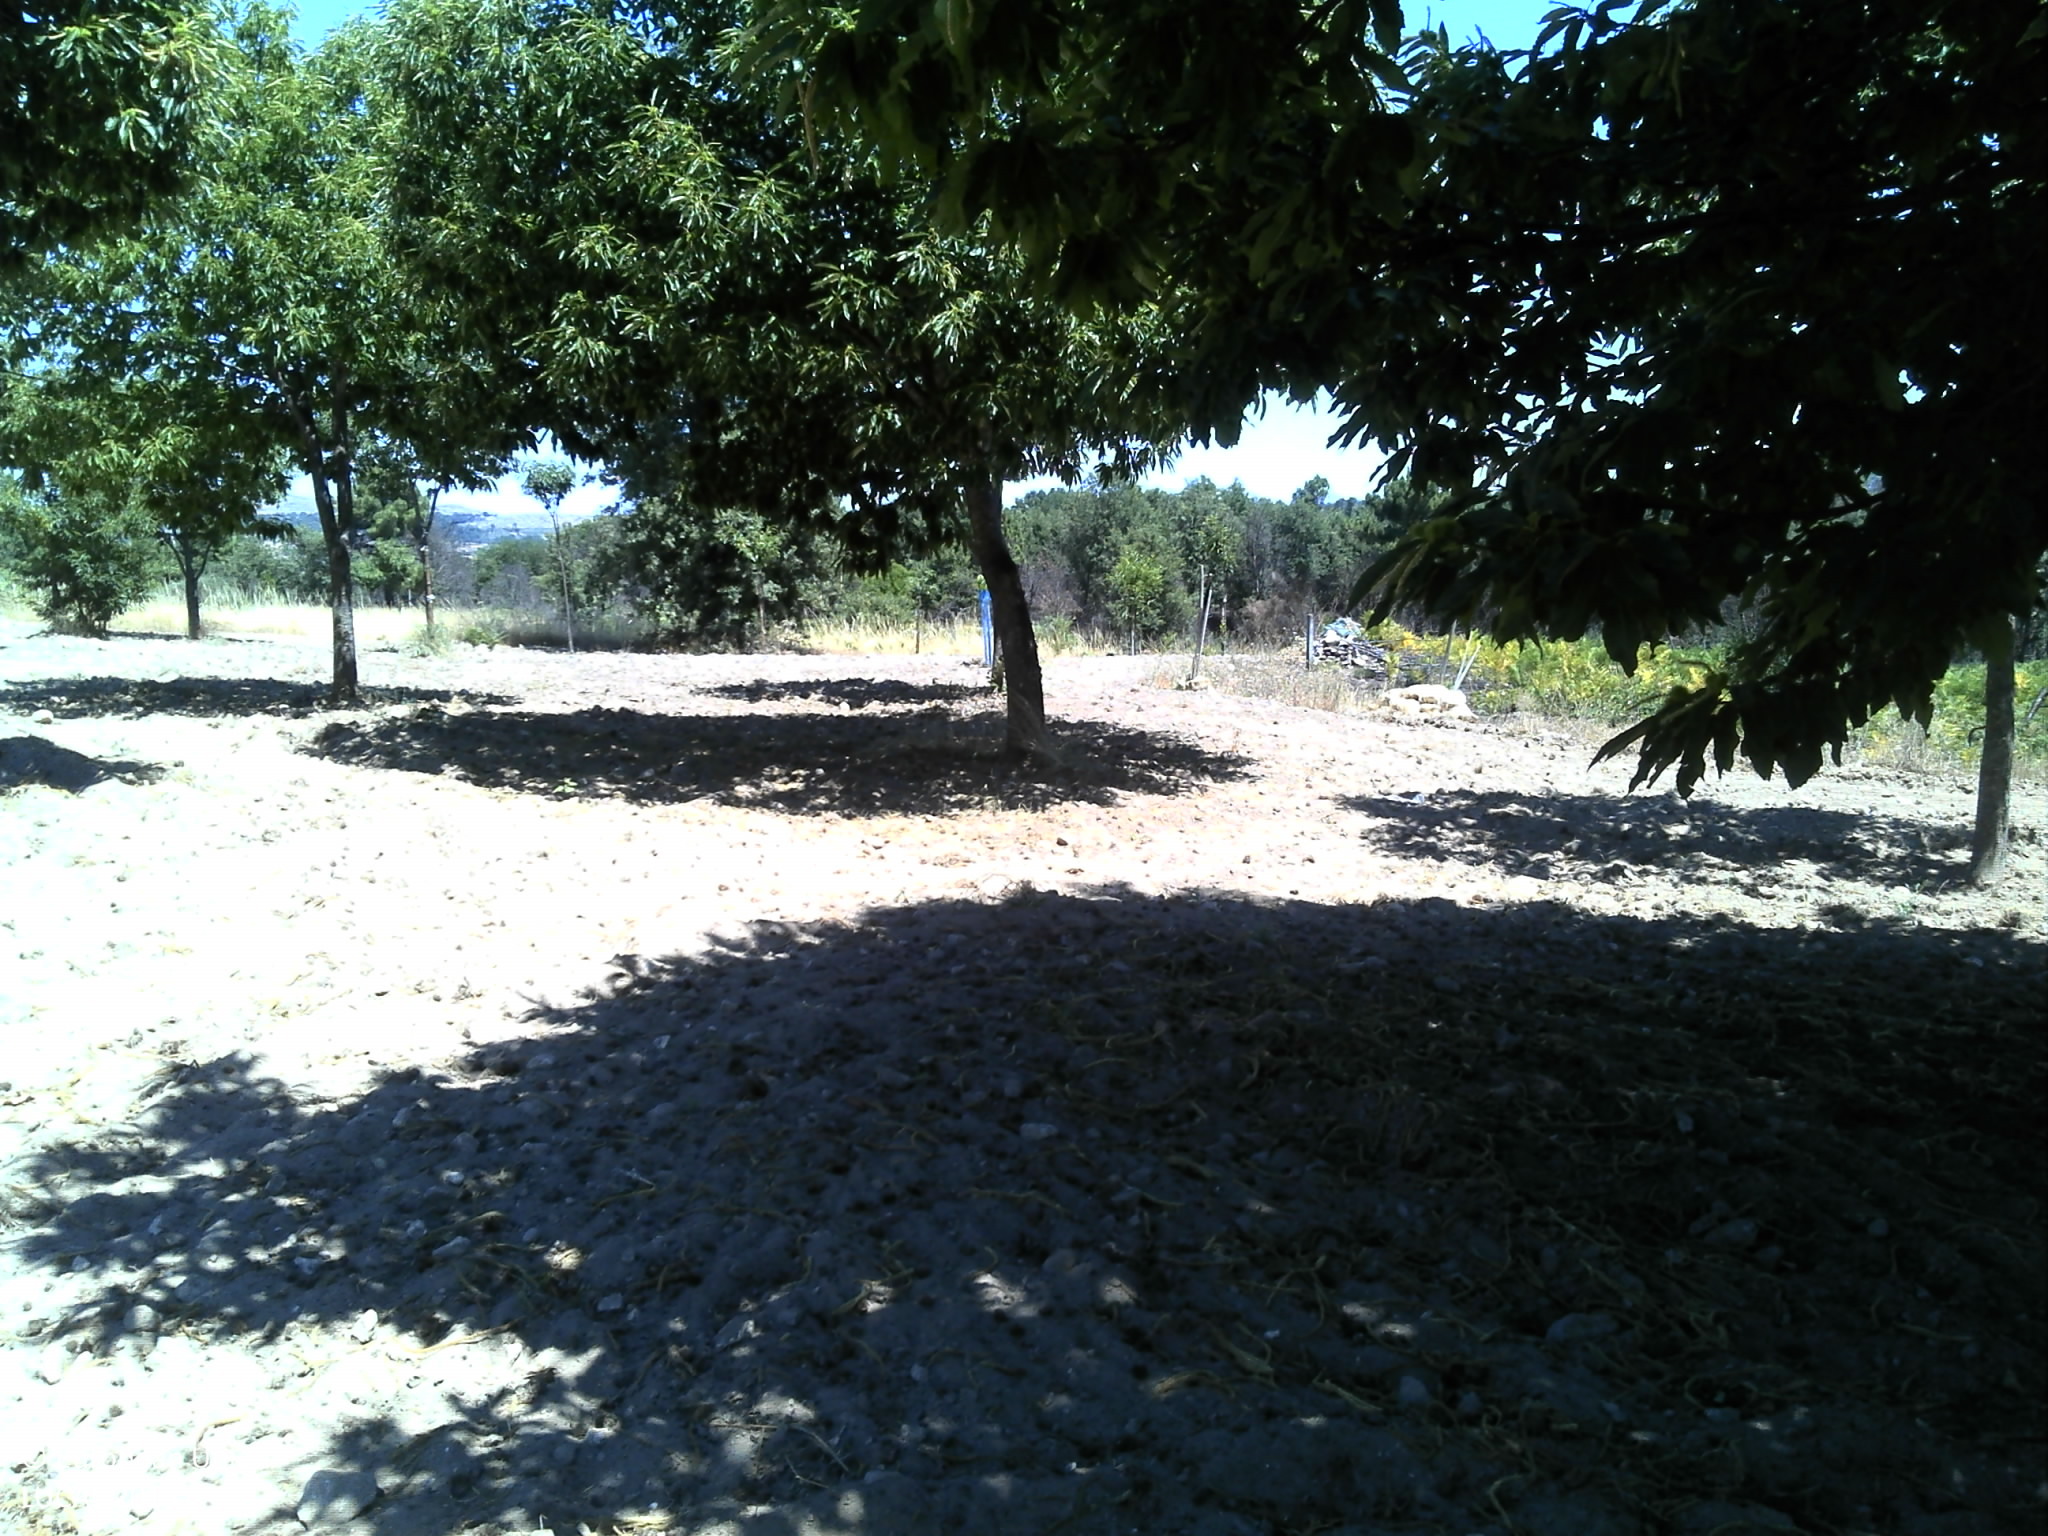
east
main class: Cropland
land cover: Nuts trees
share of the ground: 25 - 50 %
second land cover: Other bare soil
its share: > 75 %
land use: Agriculture (excluding fallow land and kitchen gardens)
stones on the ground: 10 - 25 %
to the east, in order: Nuts trees; Other bare soil; Nuts trees; Other fruit trees and berries; Shrubland without tree cover; Shrubland with sparse tree cover; Other fruit trees and berries; Broadleaved woodland; Tracks; Broadleaved woodland; Shrubland without tree cover; Broadleaved woodland
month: July
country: PT
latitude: 41.7213
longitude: -7.6237
